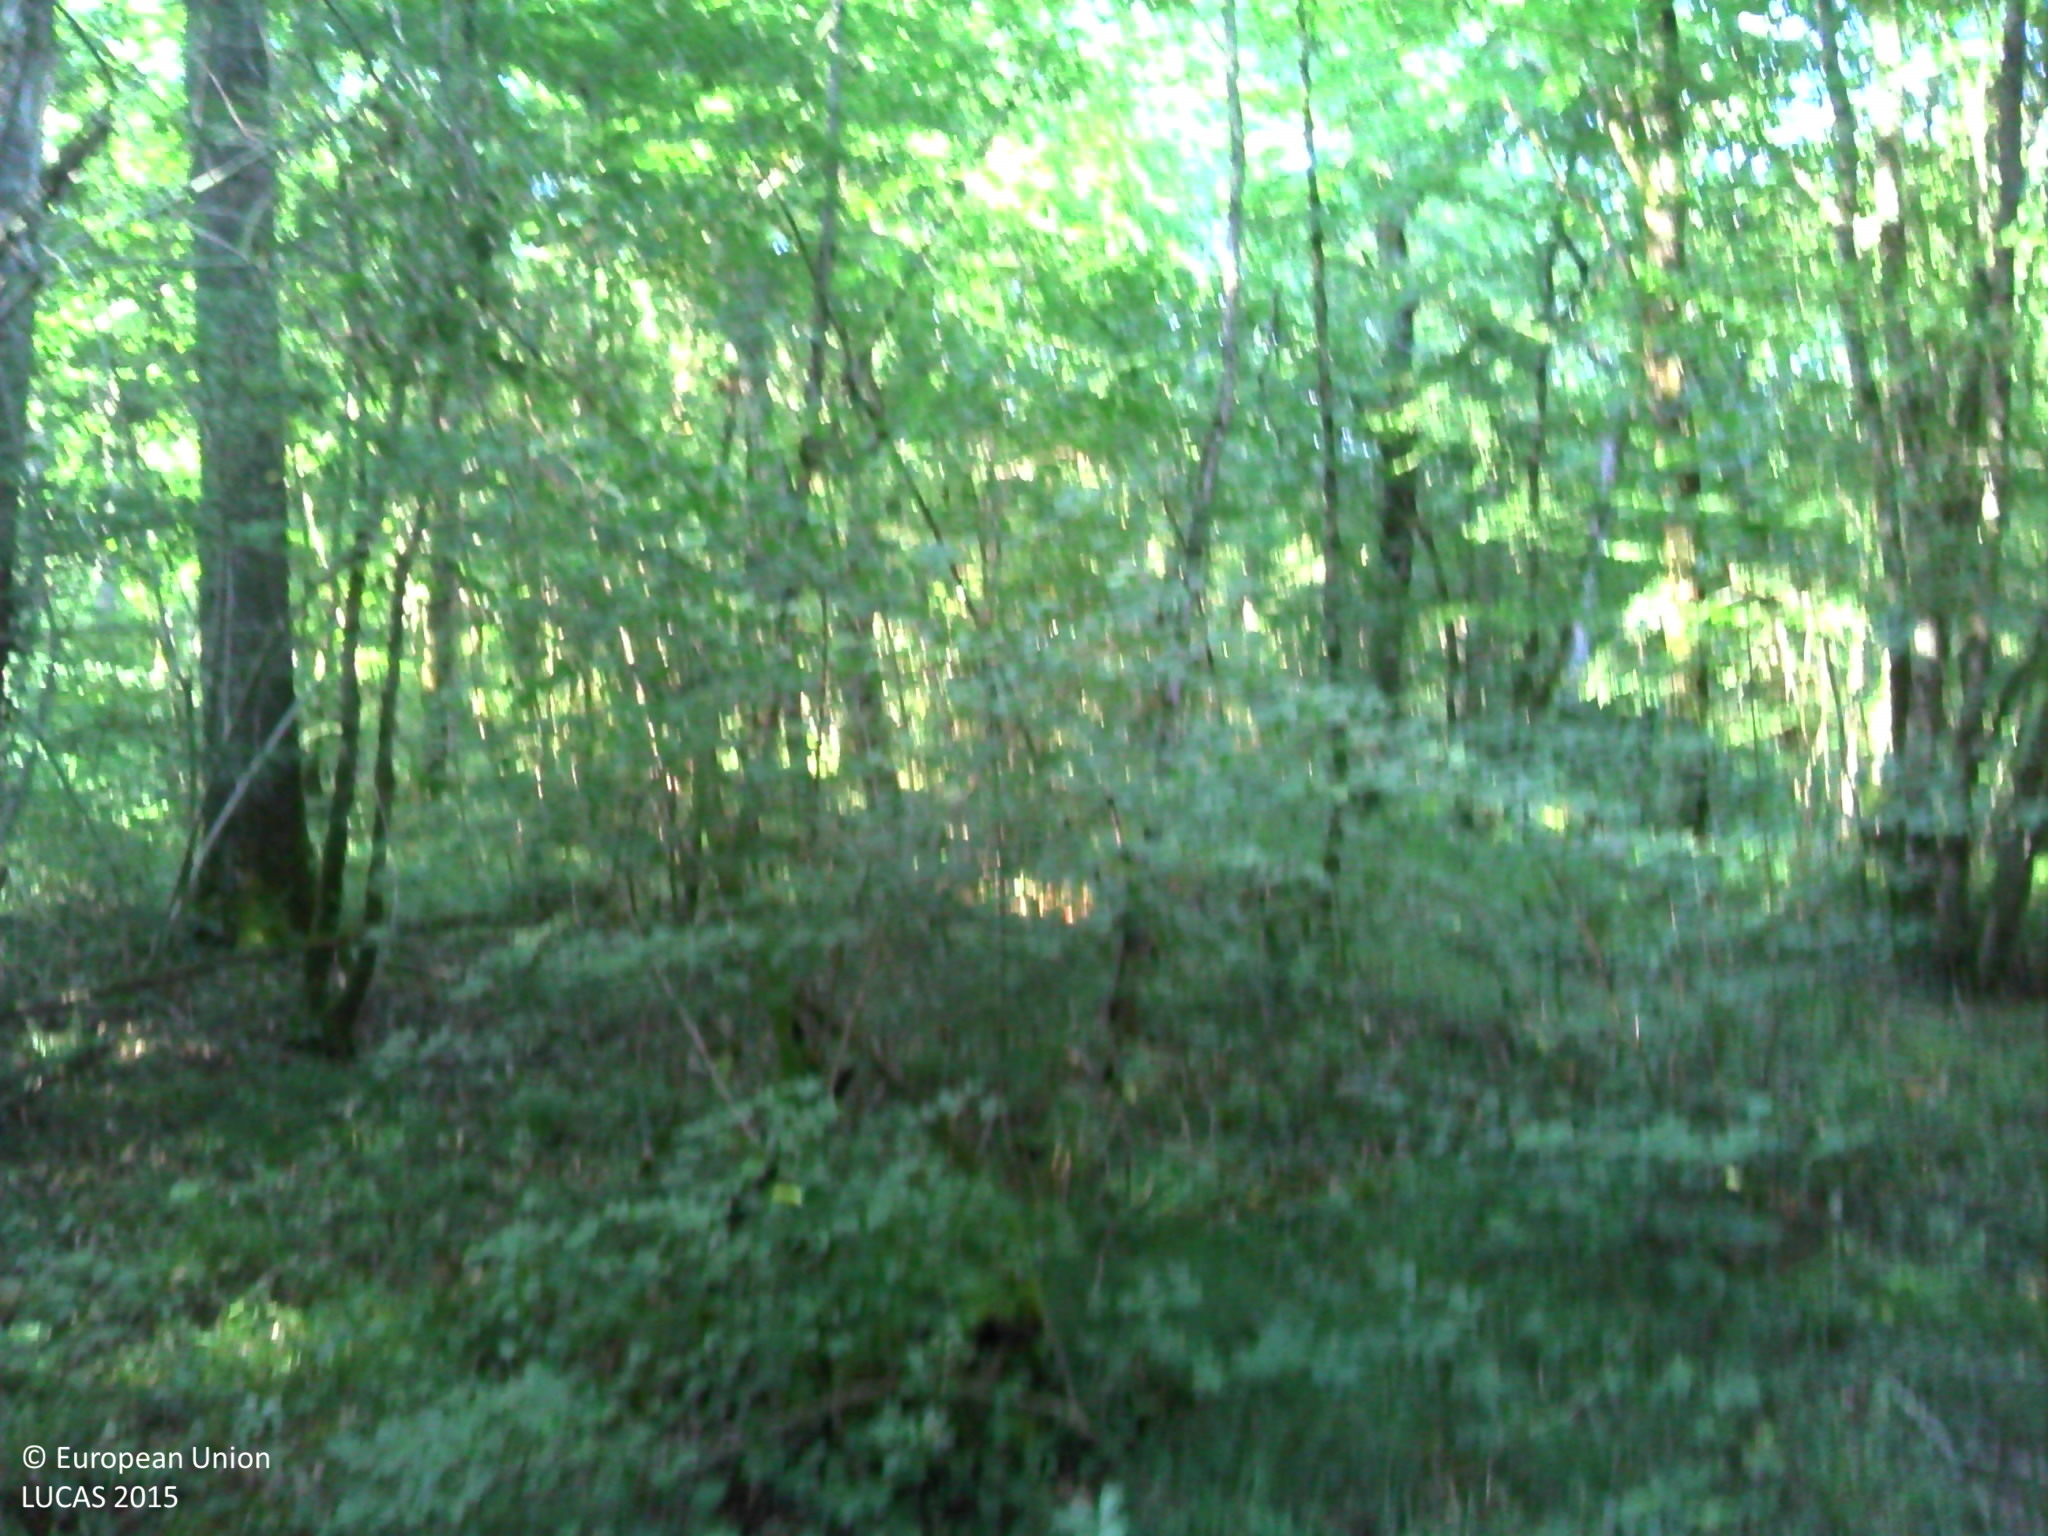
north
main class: Woodland
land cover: Broadleaved woodland
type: mesophytic deciduous forest
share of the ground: > 75 %
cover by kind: broadleaved forest trees 100 %
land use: Forestry
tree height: > 5 m
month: August
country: FR
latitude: 47.1793
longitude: 2.0868
